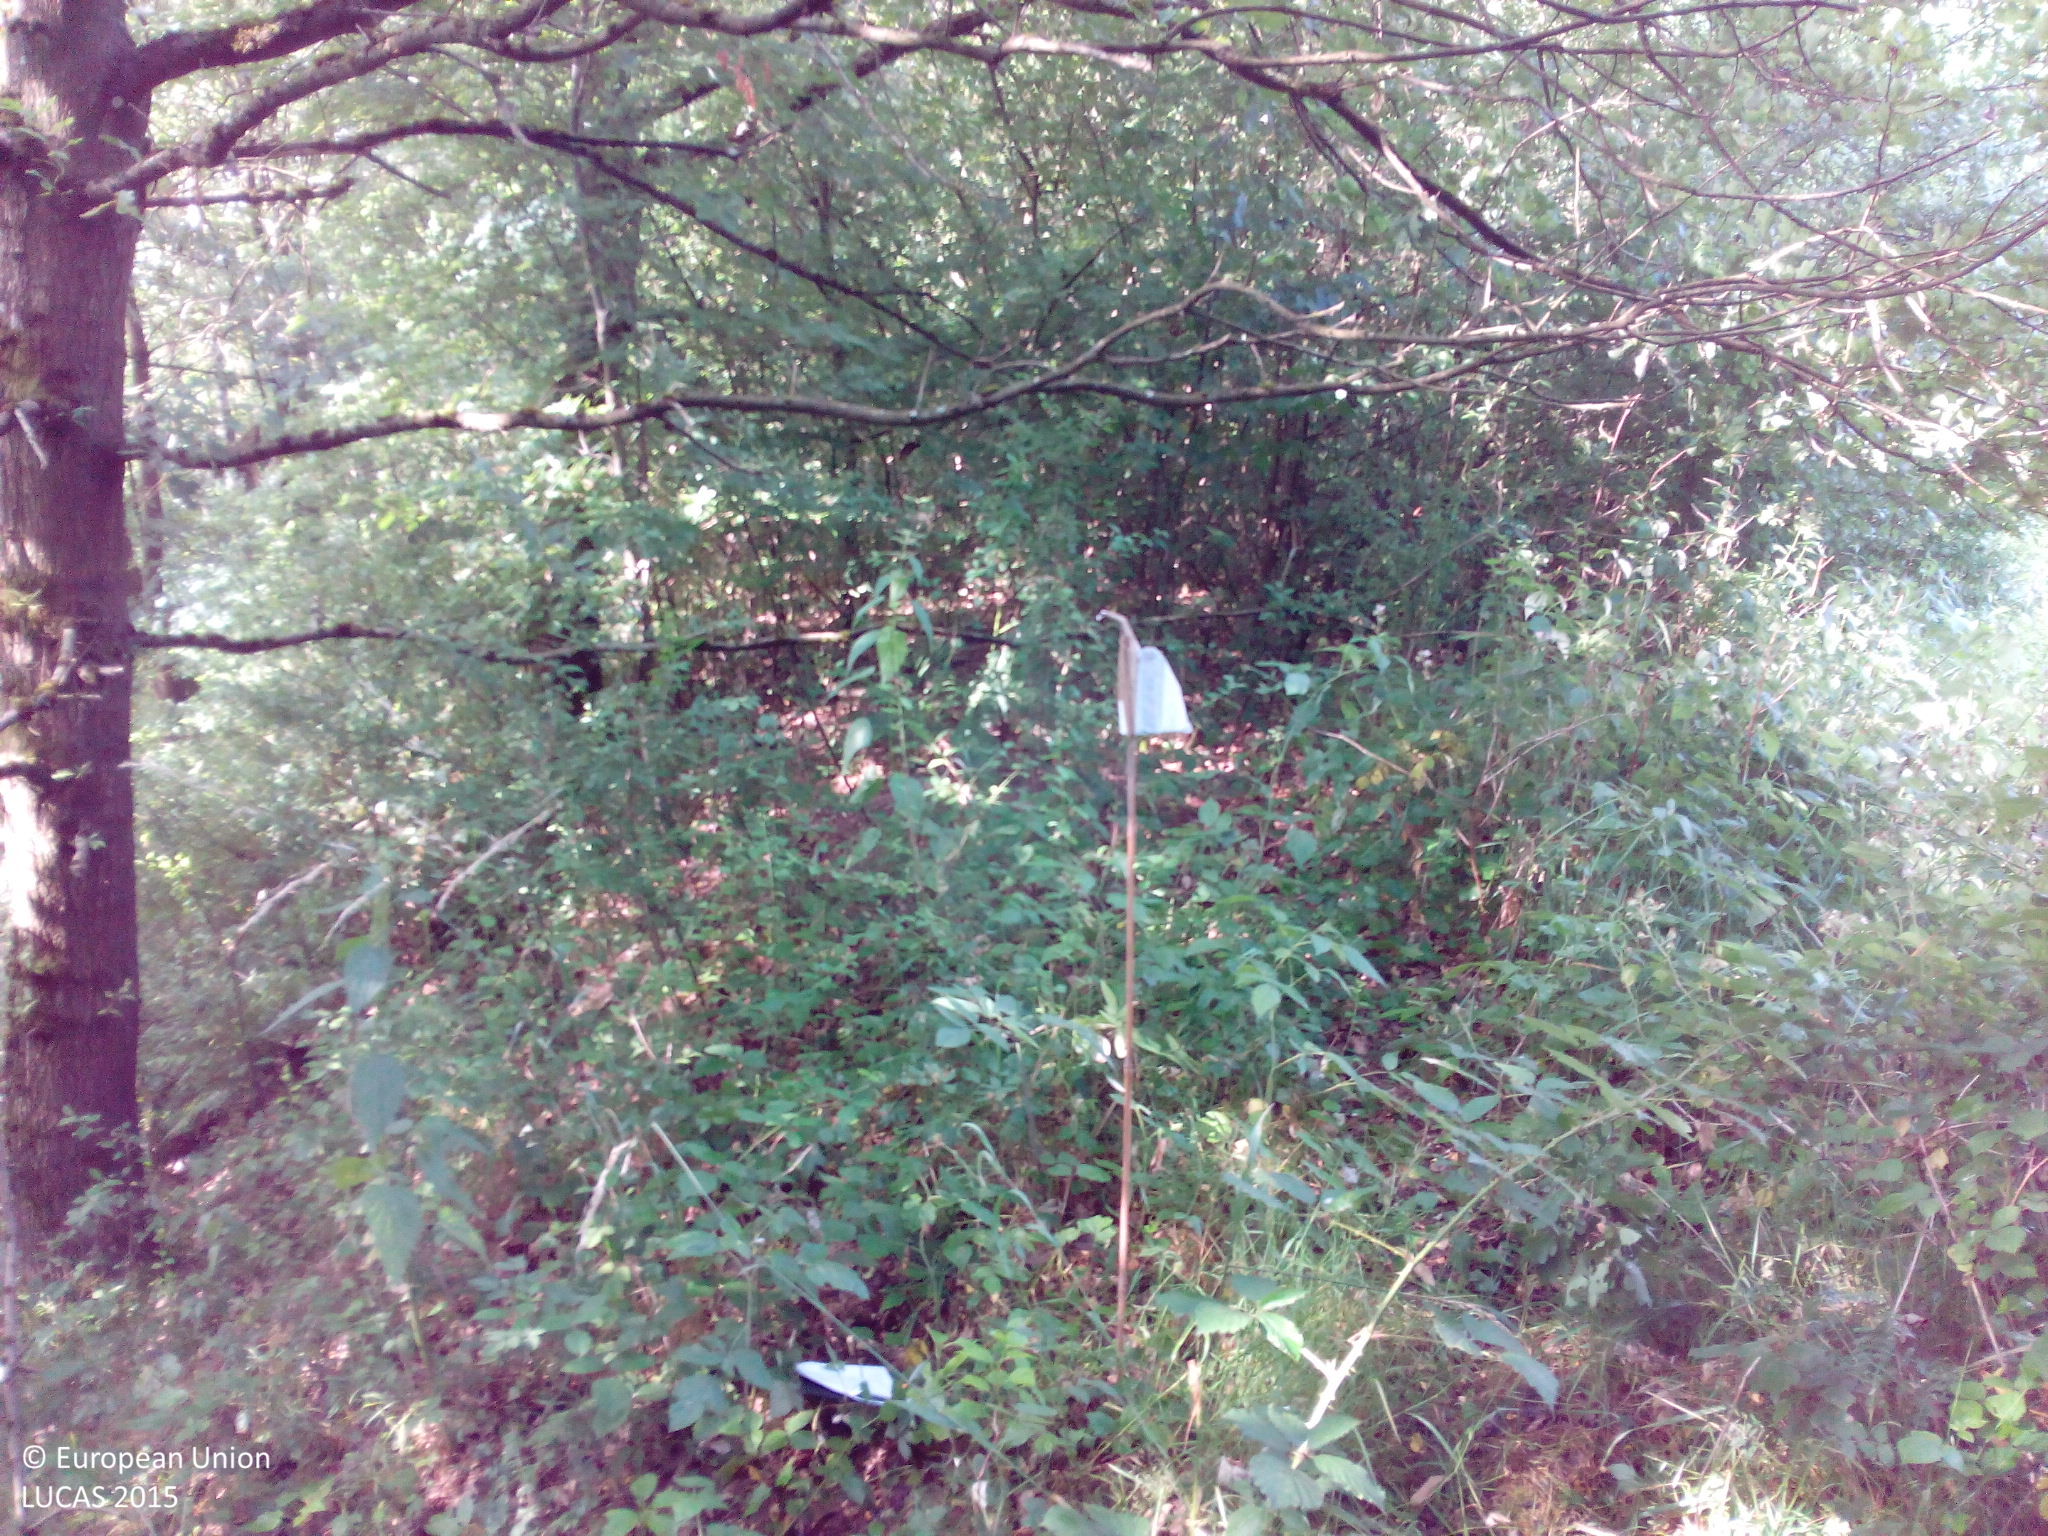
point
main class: Woodland
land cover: Broadleaved woodland
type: mesophytic deciduous forest
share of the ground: > 75 %
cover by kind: broadleaved forest trees 100 %
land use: Forestry
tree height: > 5 m
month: July
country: DE
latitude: 49.4467
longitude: 7.1452
